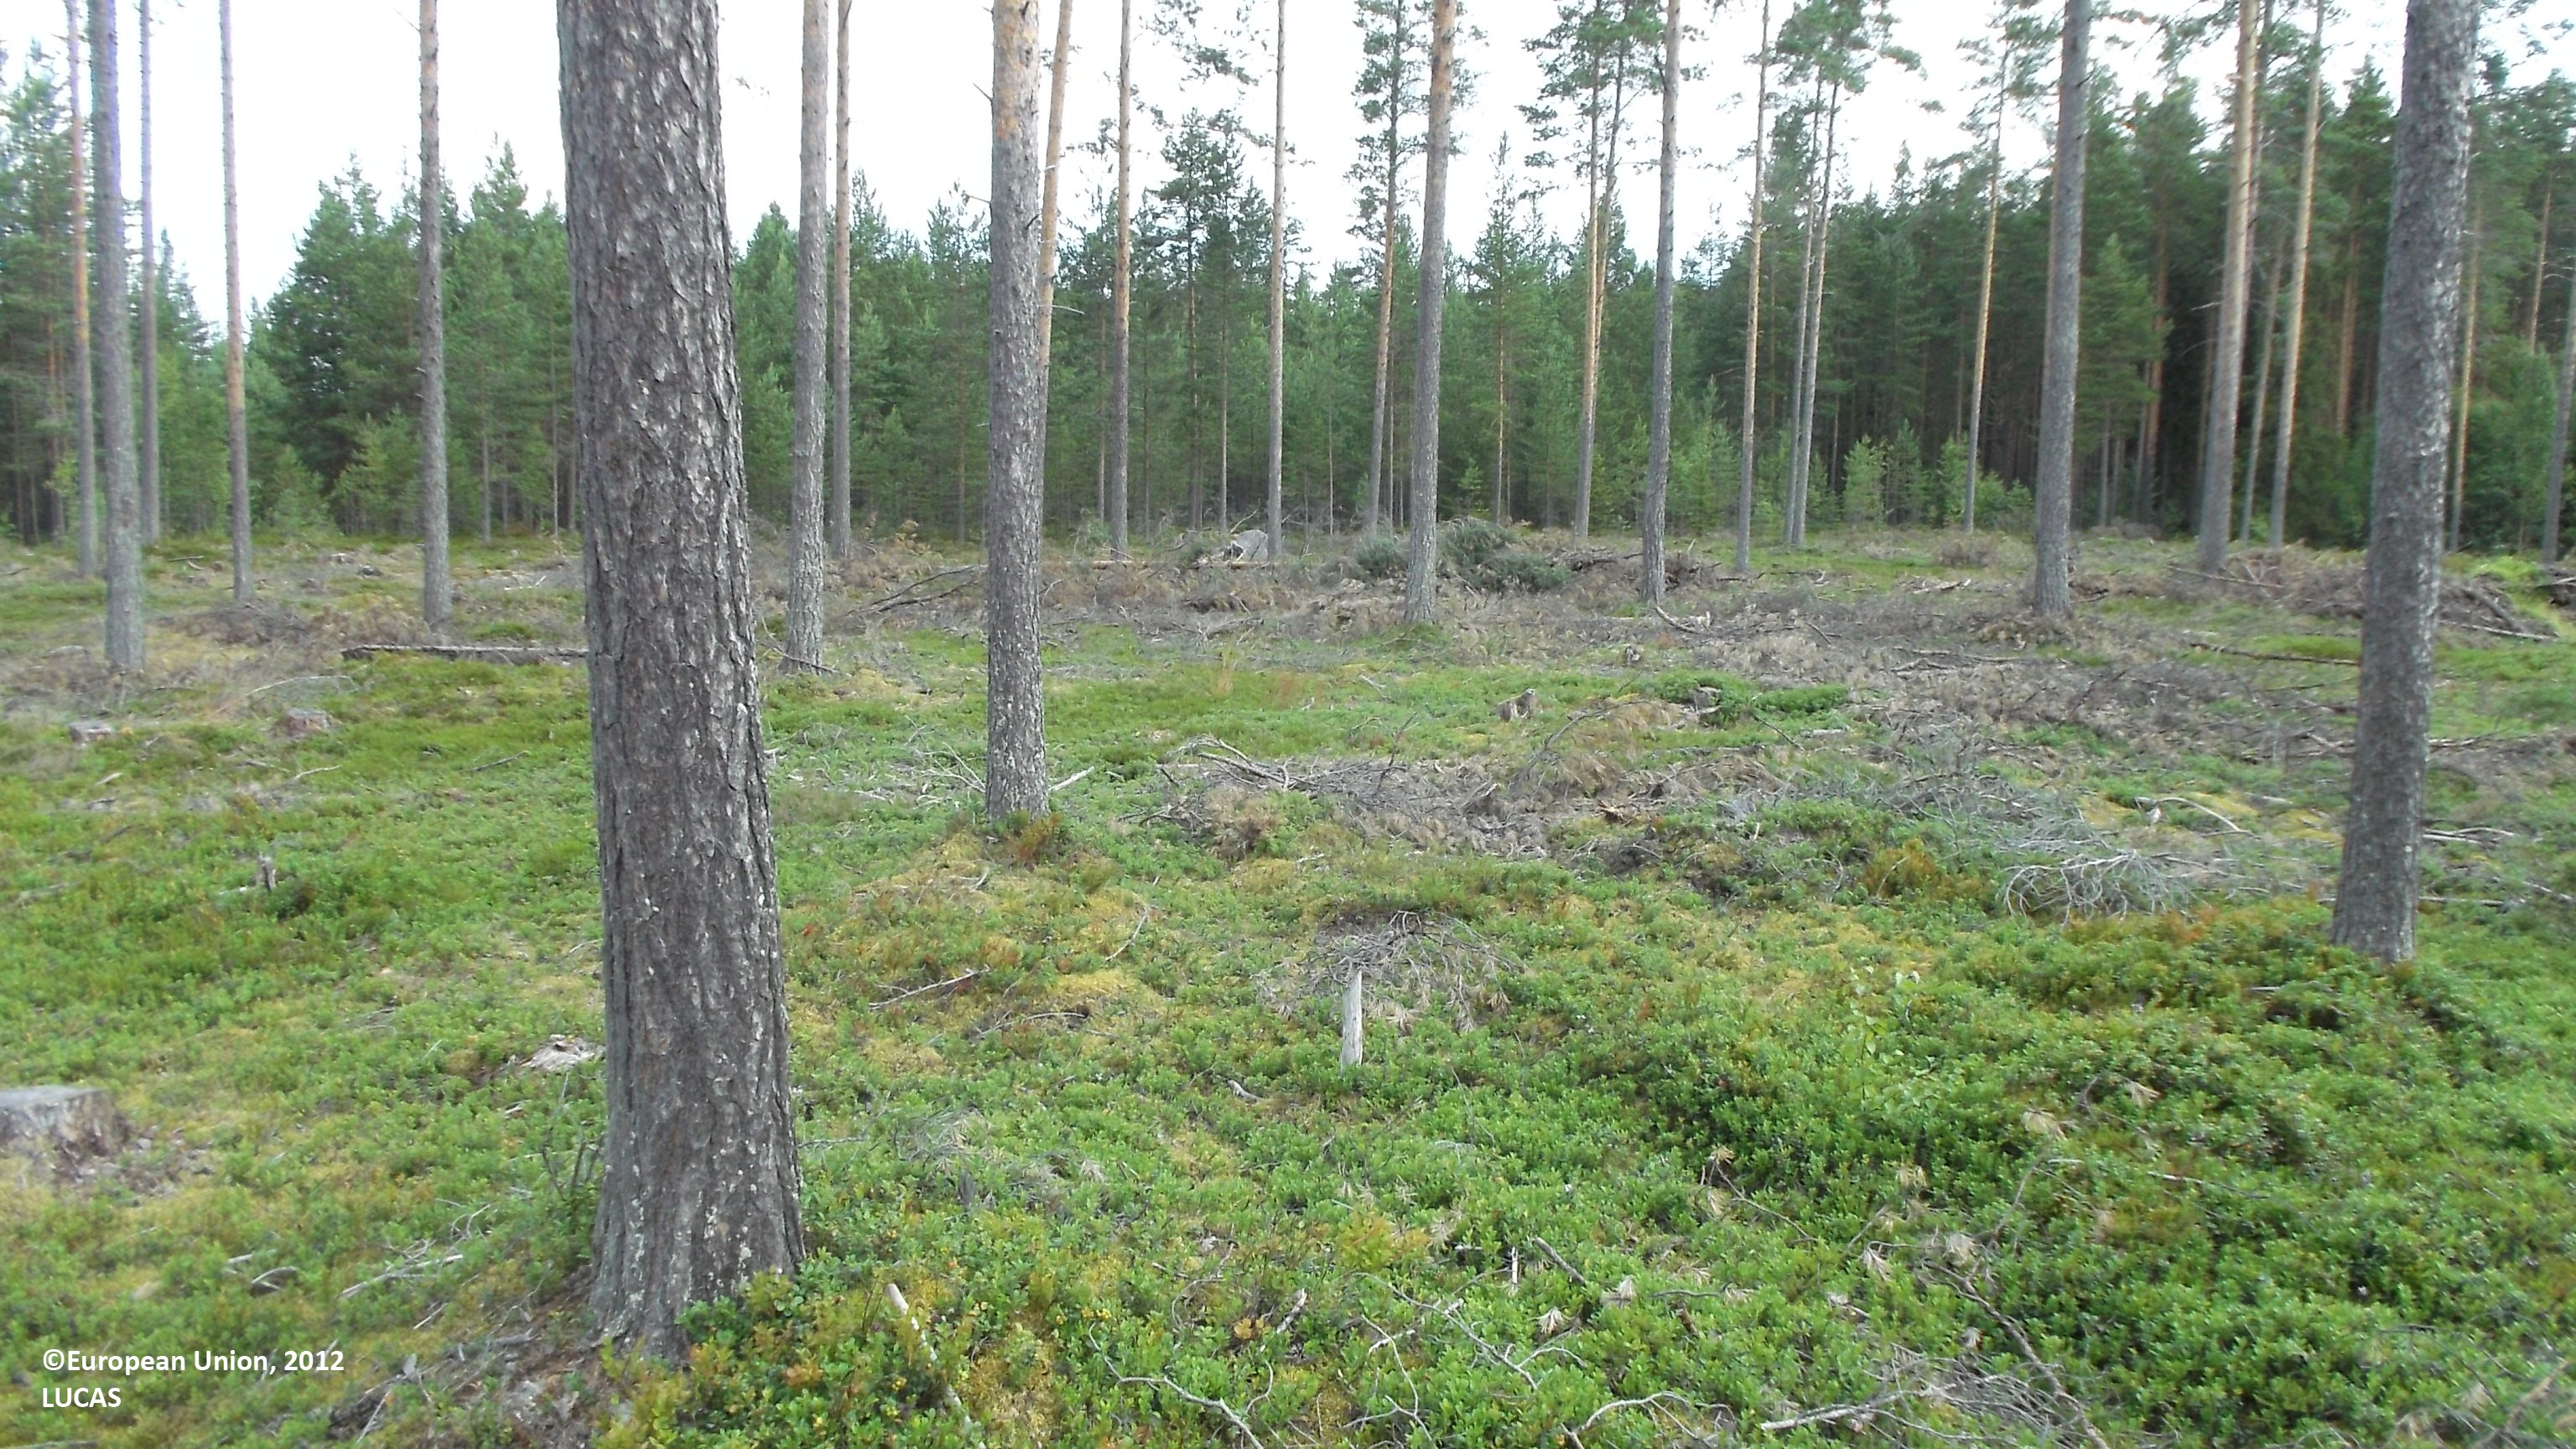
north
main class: Woodland
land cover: Pine dominated coniferous woodland
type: boreal forest
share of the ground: 10 - 25 %
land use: Forestry
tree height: > 5 m
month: July
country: FI
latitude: 63.9707
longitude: 23.4343
